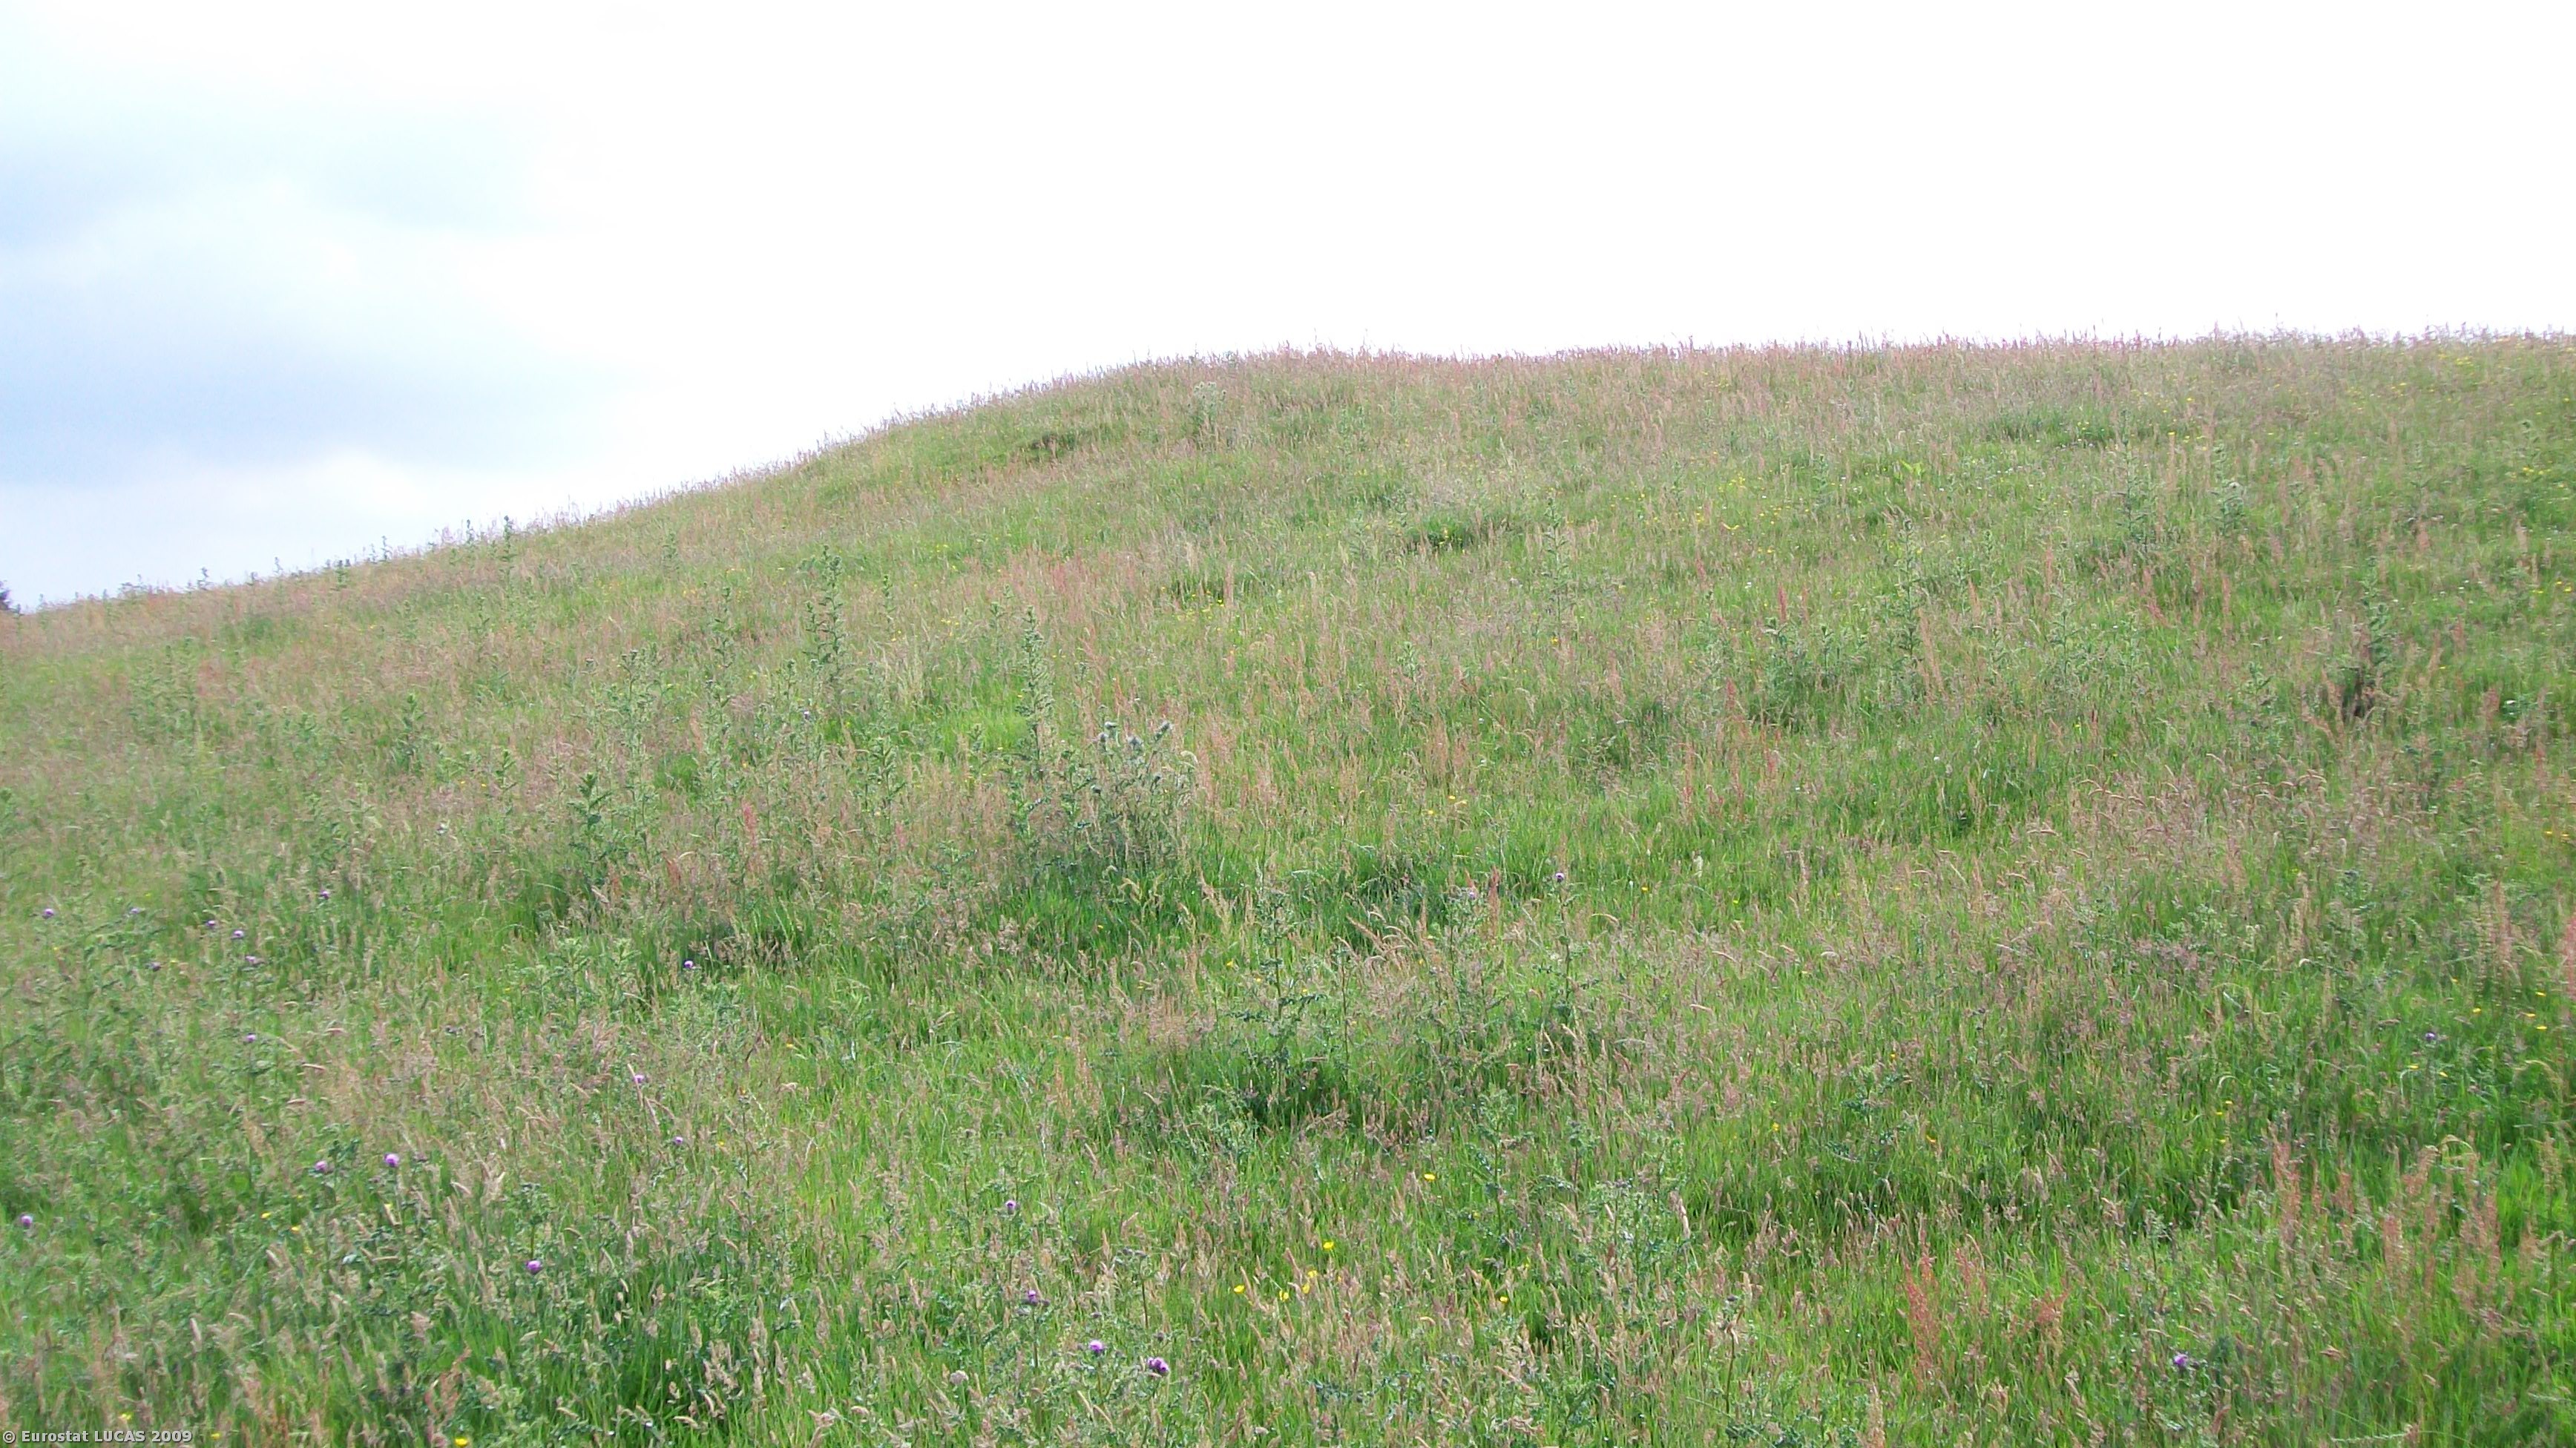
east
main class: Grassland
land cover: Grassland without tree/shrub cover
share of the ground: > 75 %
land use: Agriculture (excluding fallow land and kitchen gardens)
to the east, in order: Grassland without tree/shrub cover; Grassland with sparse tree/shrub cover; Rivers and streams; Grassland without tree/shrub cover; Fences; Broadleaved woodland; Paved roads, cycling and walking lanes; Grass margins; Fences; Grassland without tree/shrub cover
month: July
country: GB
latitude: 54.9856
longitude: -4.0790
